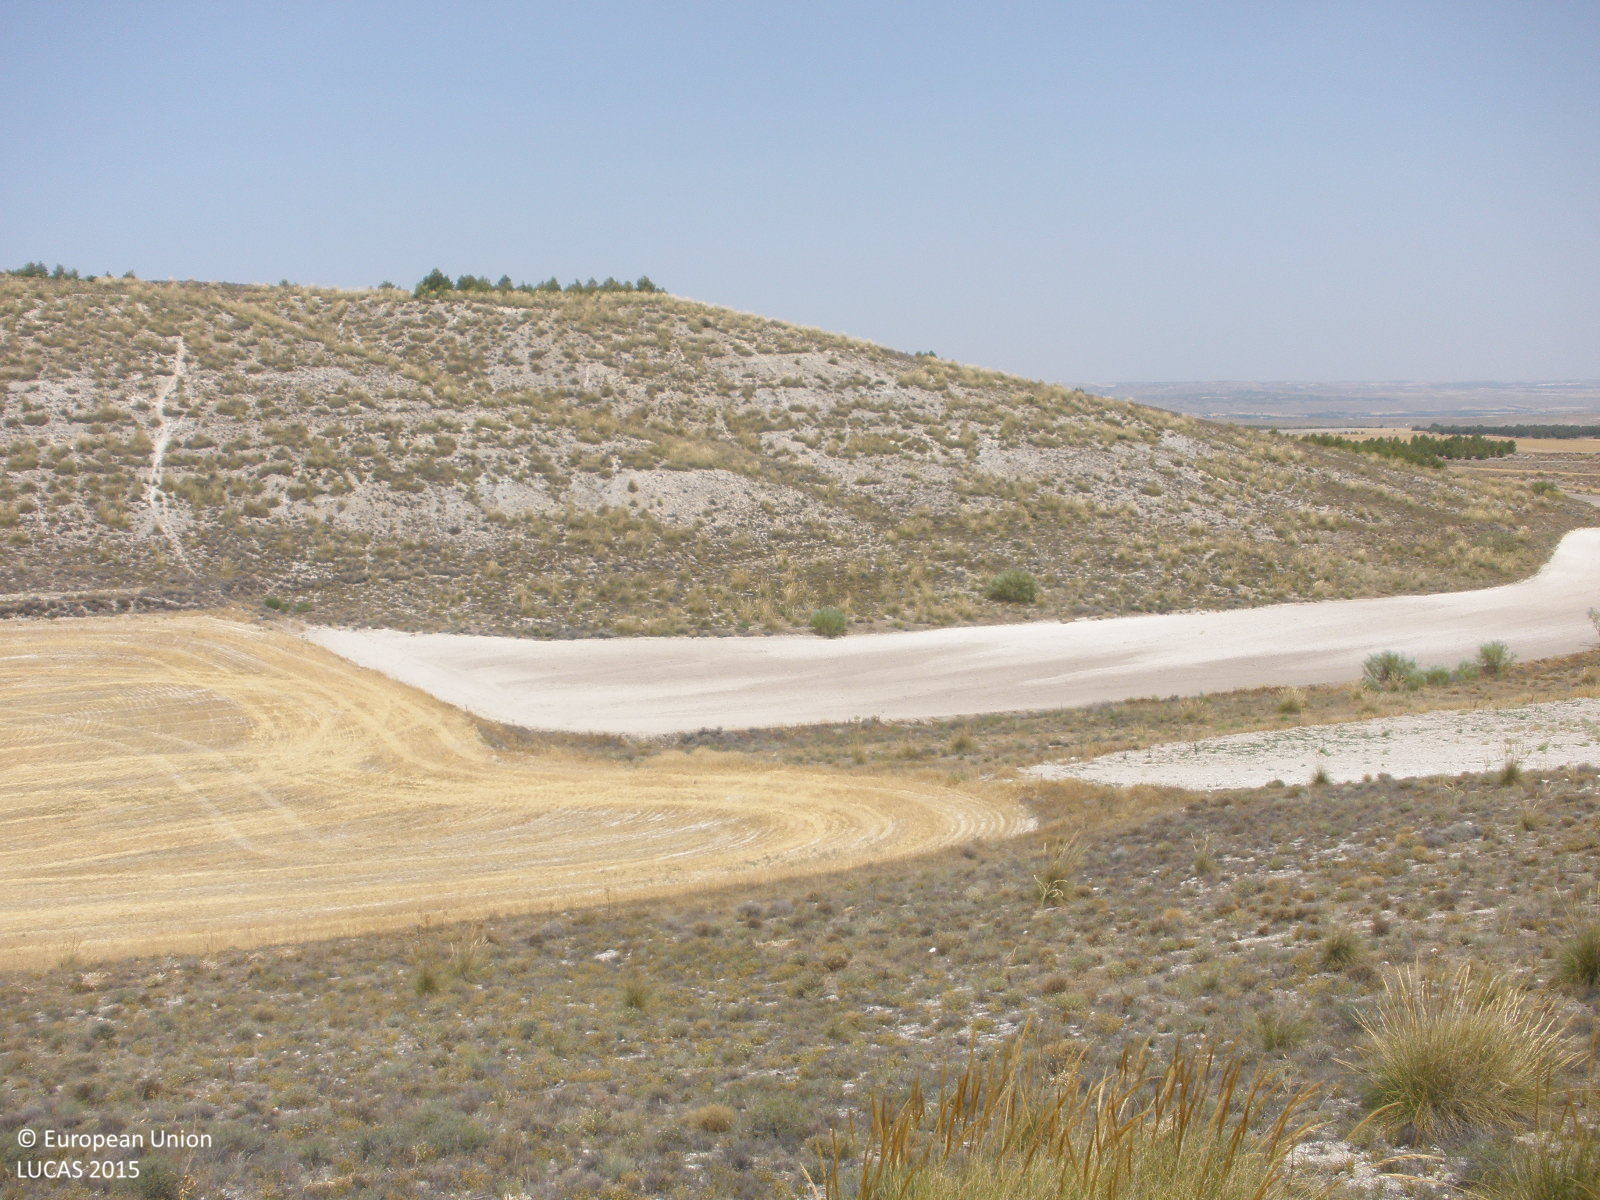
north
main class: Shrubland
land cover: Shrubland without tree cover
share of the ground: 25 - 50 %
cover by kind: herbaceous plants 50 %, shrubs 40 %, consolidated bare surface 10 %
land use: Semi-natural and natural areas not in use
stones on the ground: < 10 %
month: July
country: ES
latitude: 40.0352
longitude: -3.1632
